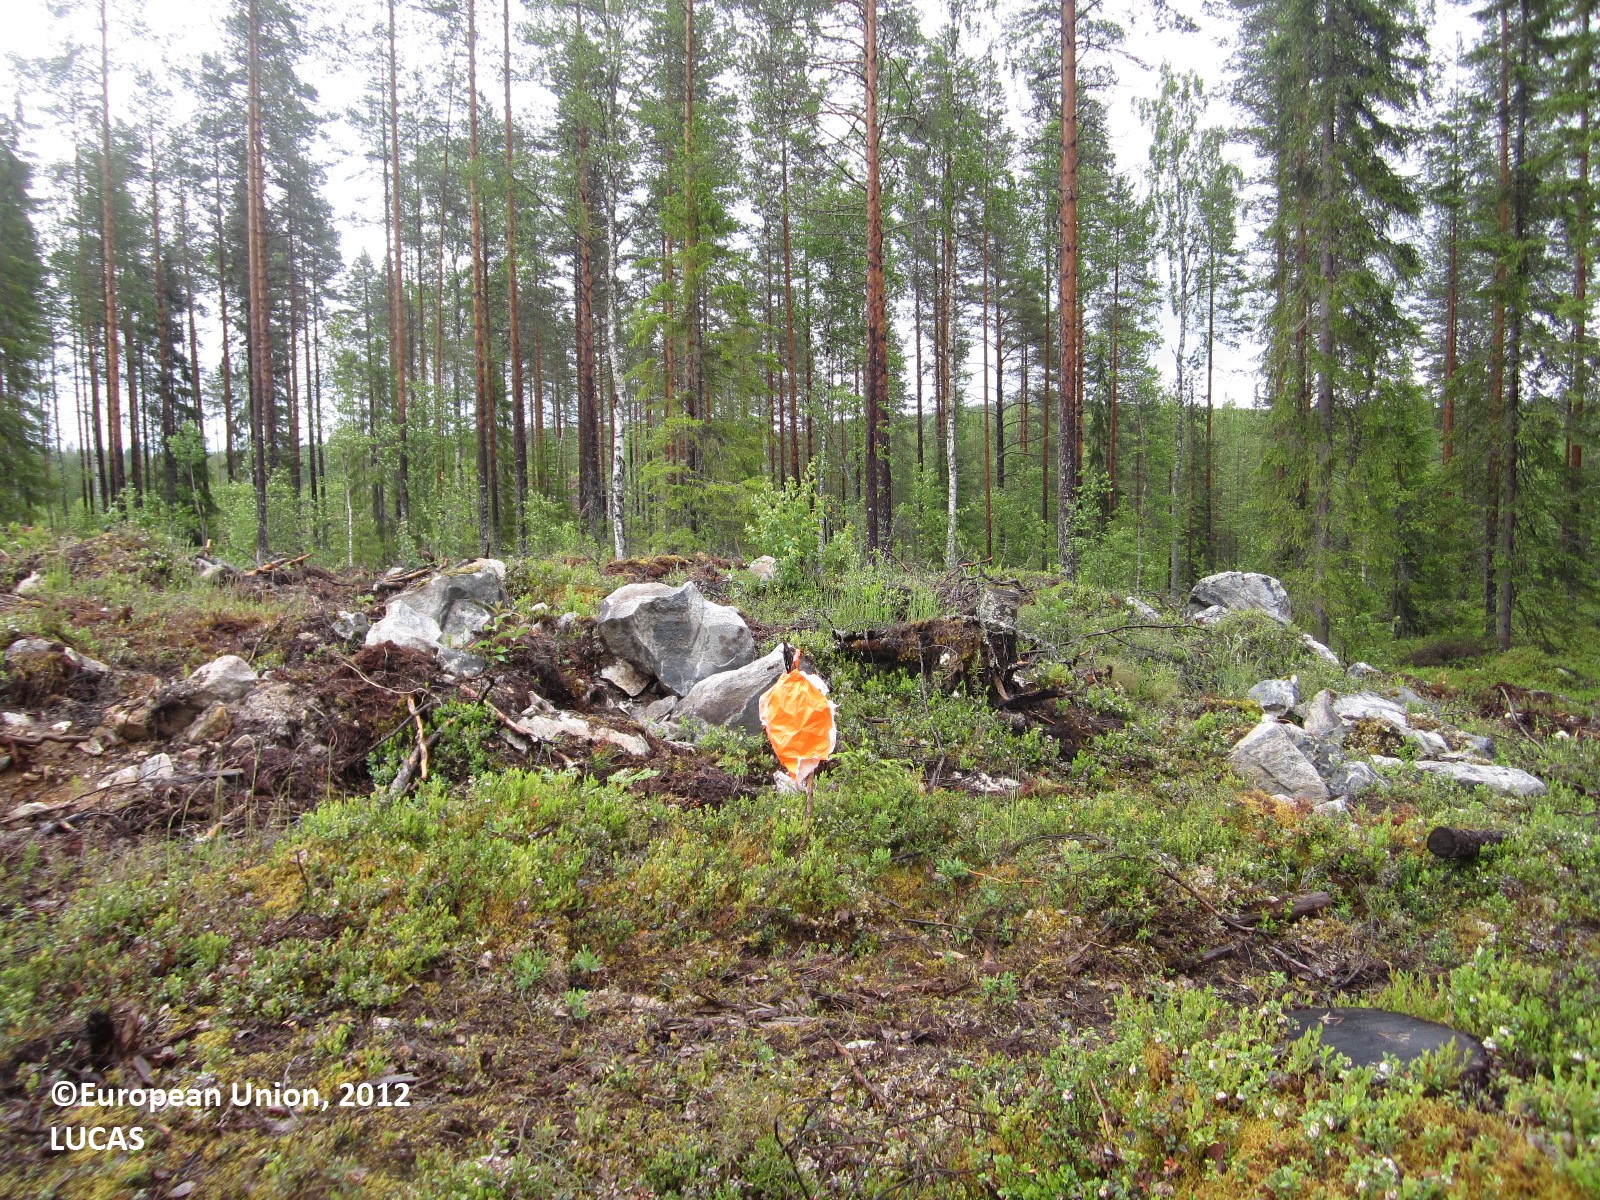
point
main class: Shrubland
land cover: Shrubland with sparse tree cover
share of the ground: 10 - 25 %
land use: Forestry
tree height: < 5 m
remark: Clear cut
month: June
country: FI
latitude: 64.2809
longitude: 29.4425
